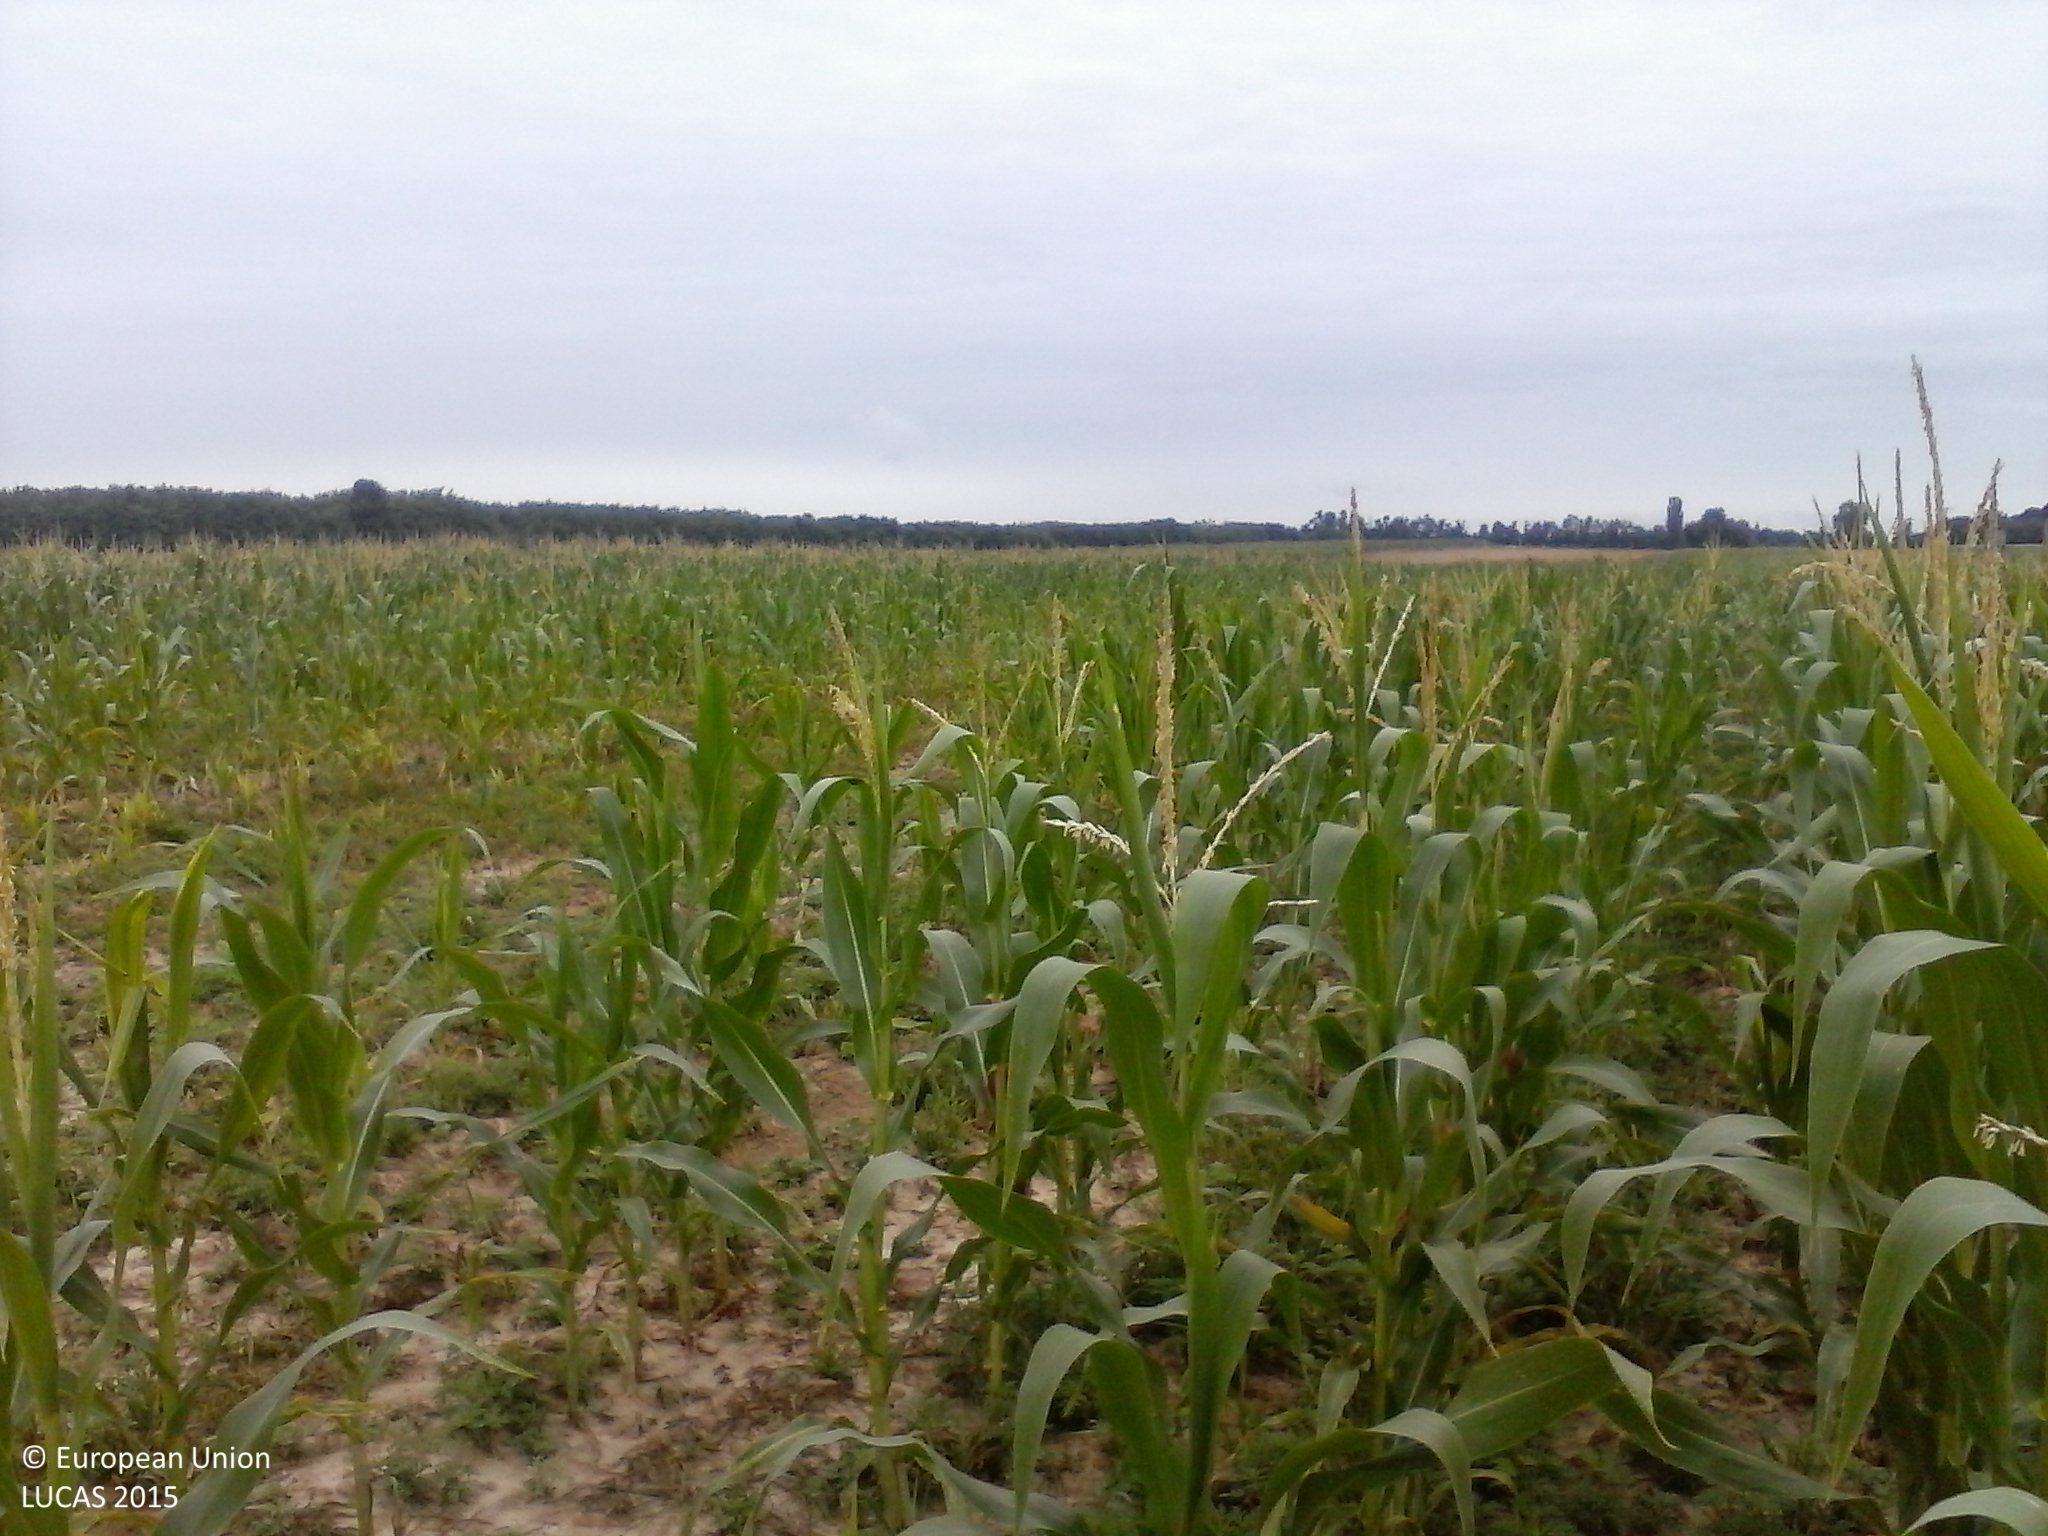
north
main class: Cropland
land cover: Maize
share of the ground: > 75 %
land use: Agriculture (excluding fallow land and kitchen gardens)
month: July
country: HU
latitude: 46.1508
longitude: 17.6305
